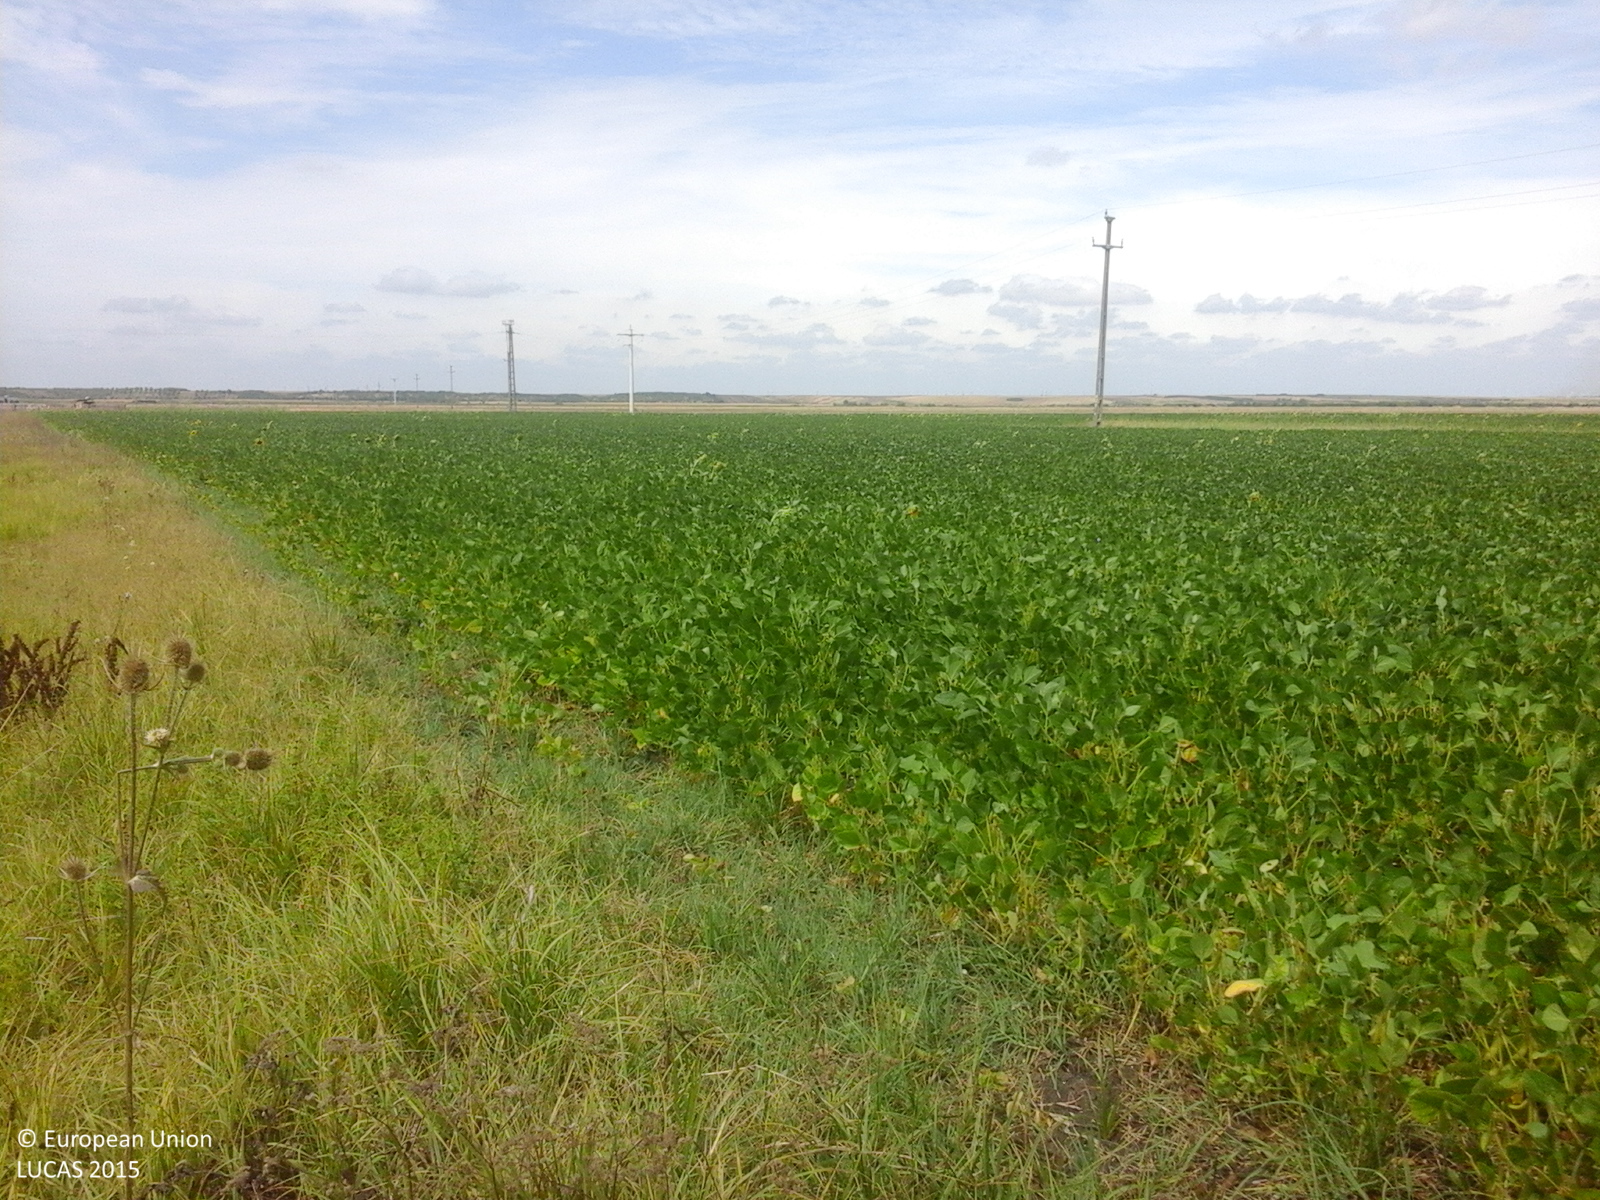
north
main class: Cropland
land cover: Soya
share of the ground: > 75 %
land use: Agriculture (excluding fallow land and kitchen gardens)
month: August
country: RO
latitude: 45.2916
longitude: 21.3390
